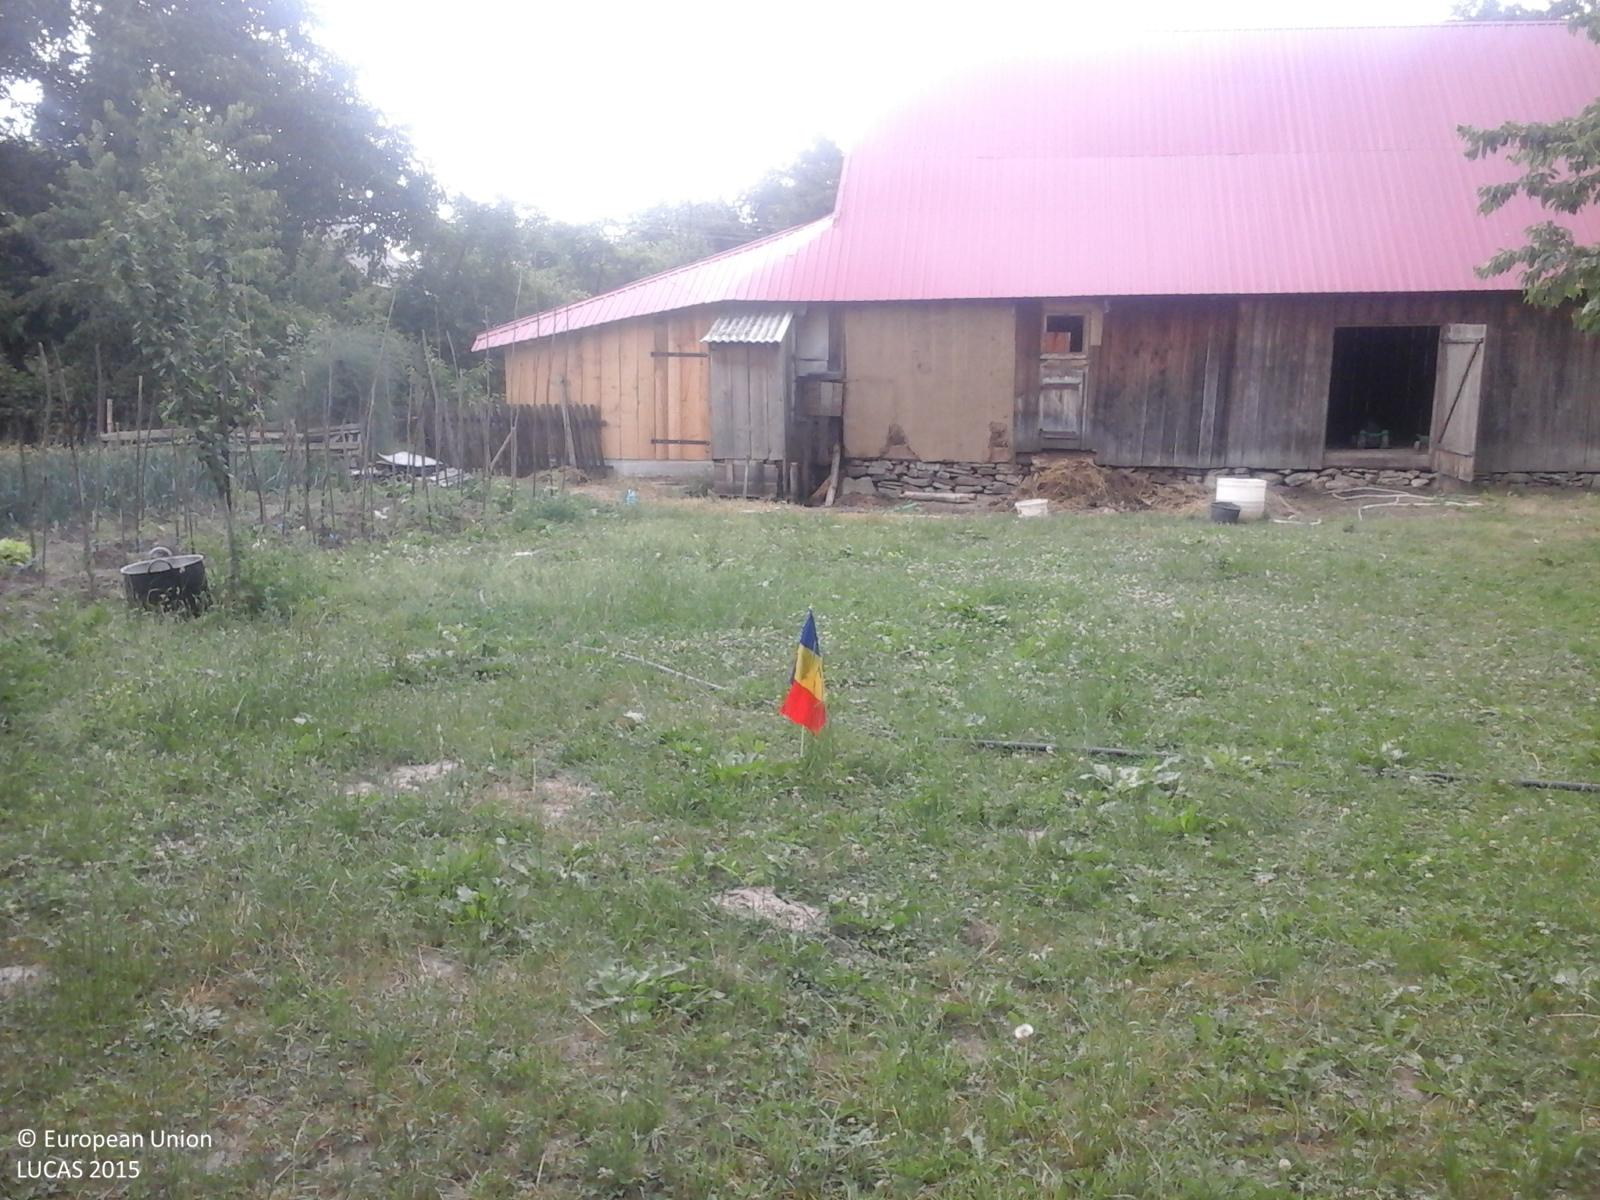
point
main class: Grassland
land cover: Grassland without tree/shrub cover
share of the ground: 50 - 75 %
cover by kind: herbaceous plants 100 %
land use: Agriculture (excluding fallow land and kitchen gardens)
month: June
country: RO
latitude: 47.6425
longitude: 25.9281
